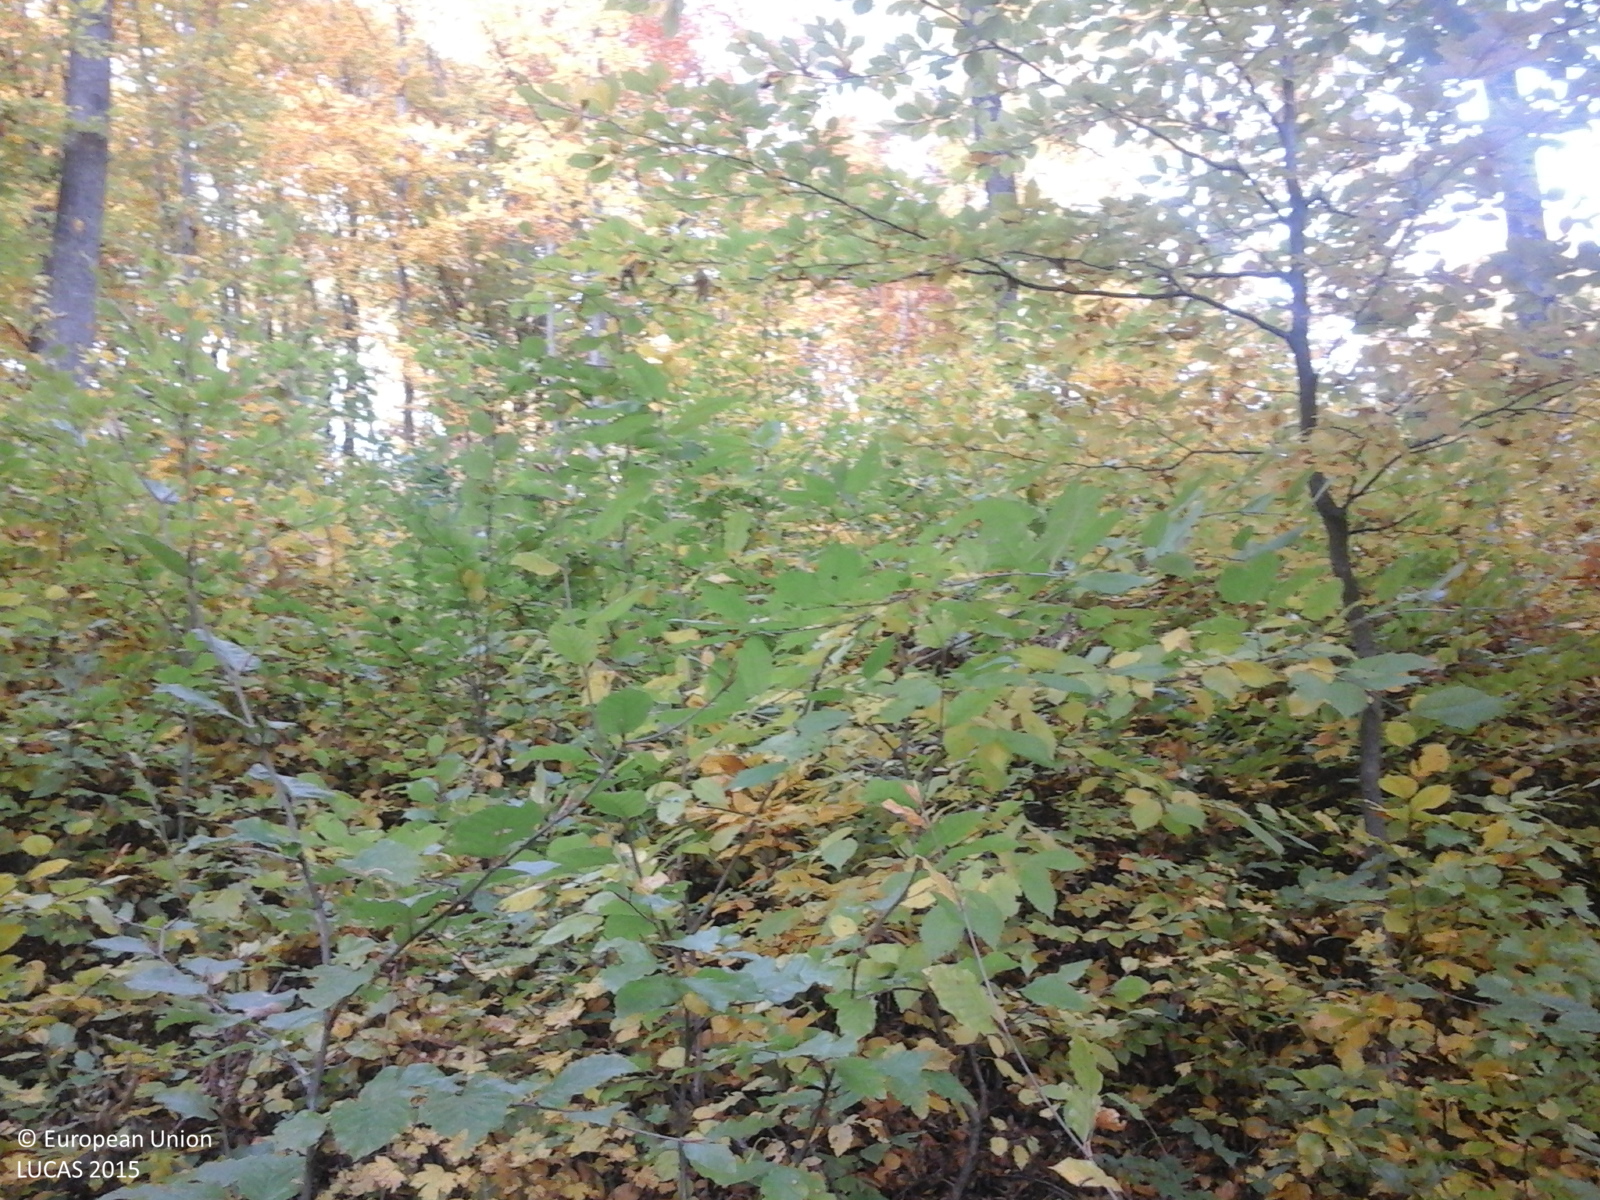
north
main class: Woodland
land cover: Broadleaved woodland
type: beech forest
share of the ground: > 75 %
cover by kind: broadleaved forest trees 100 %
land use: Forestry
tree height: > 5 m
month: October
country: RO
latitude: 45.5304
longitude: 26.7660
